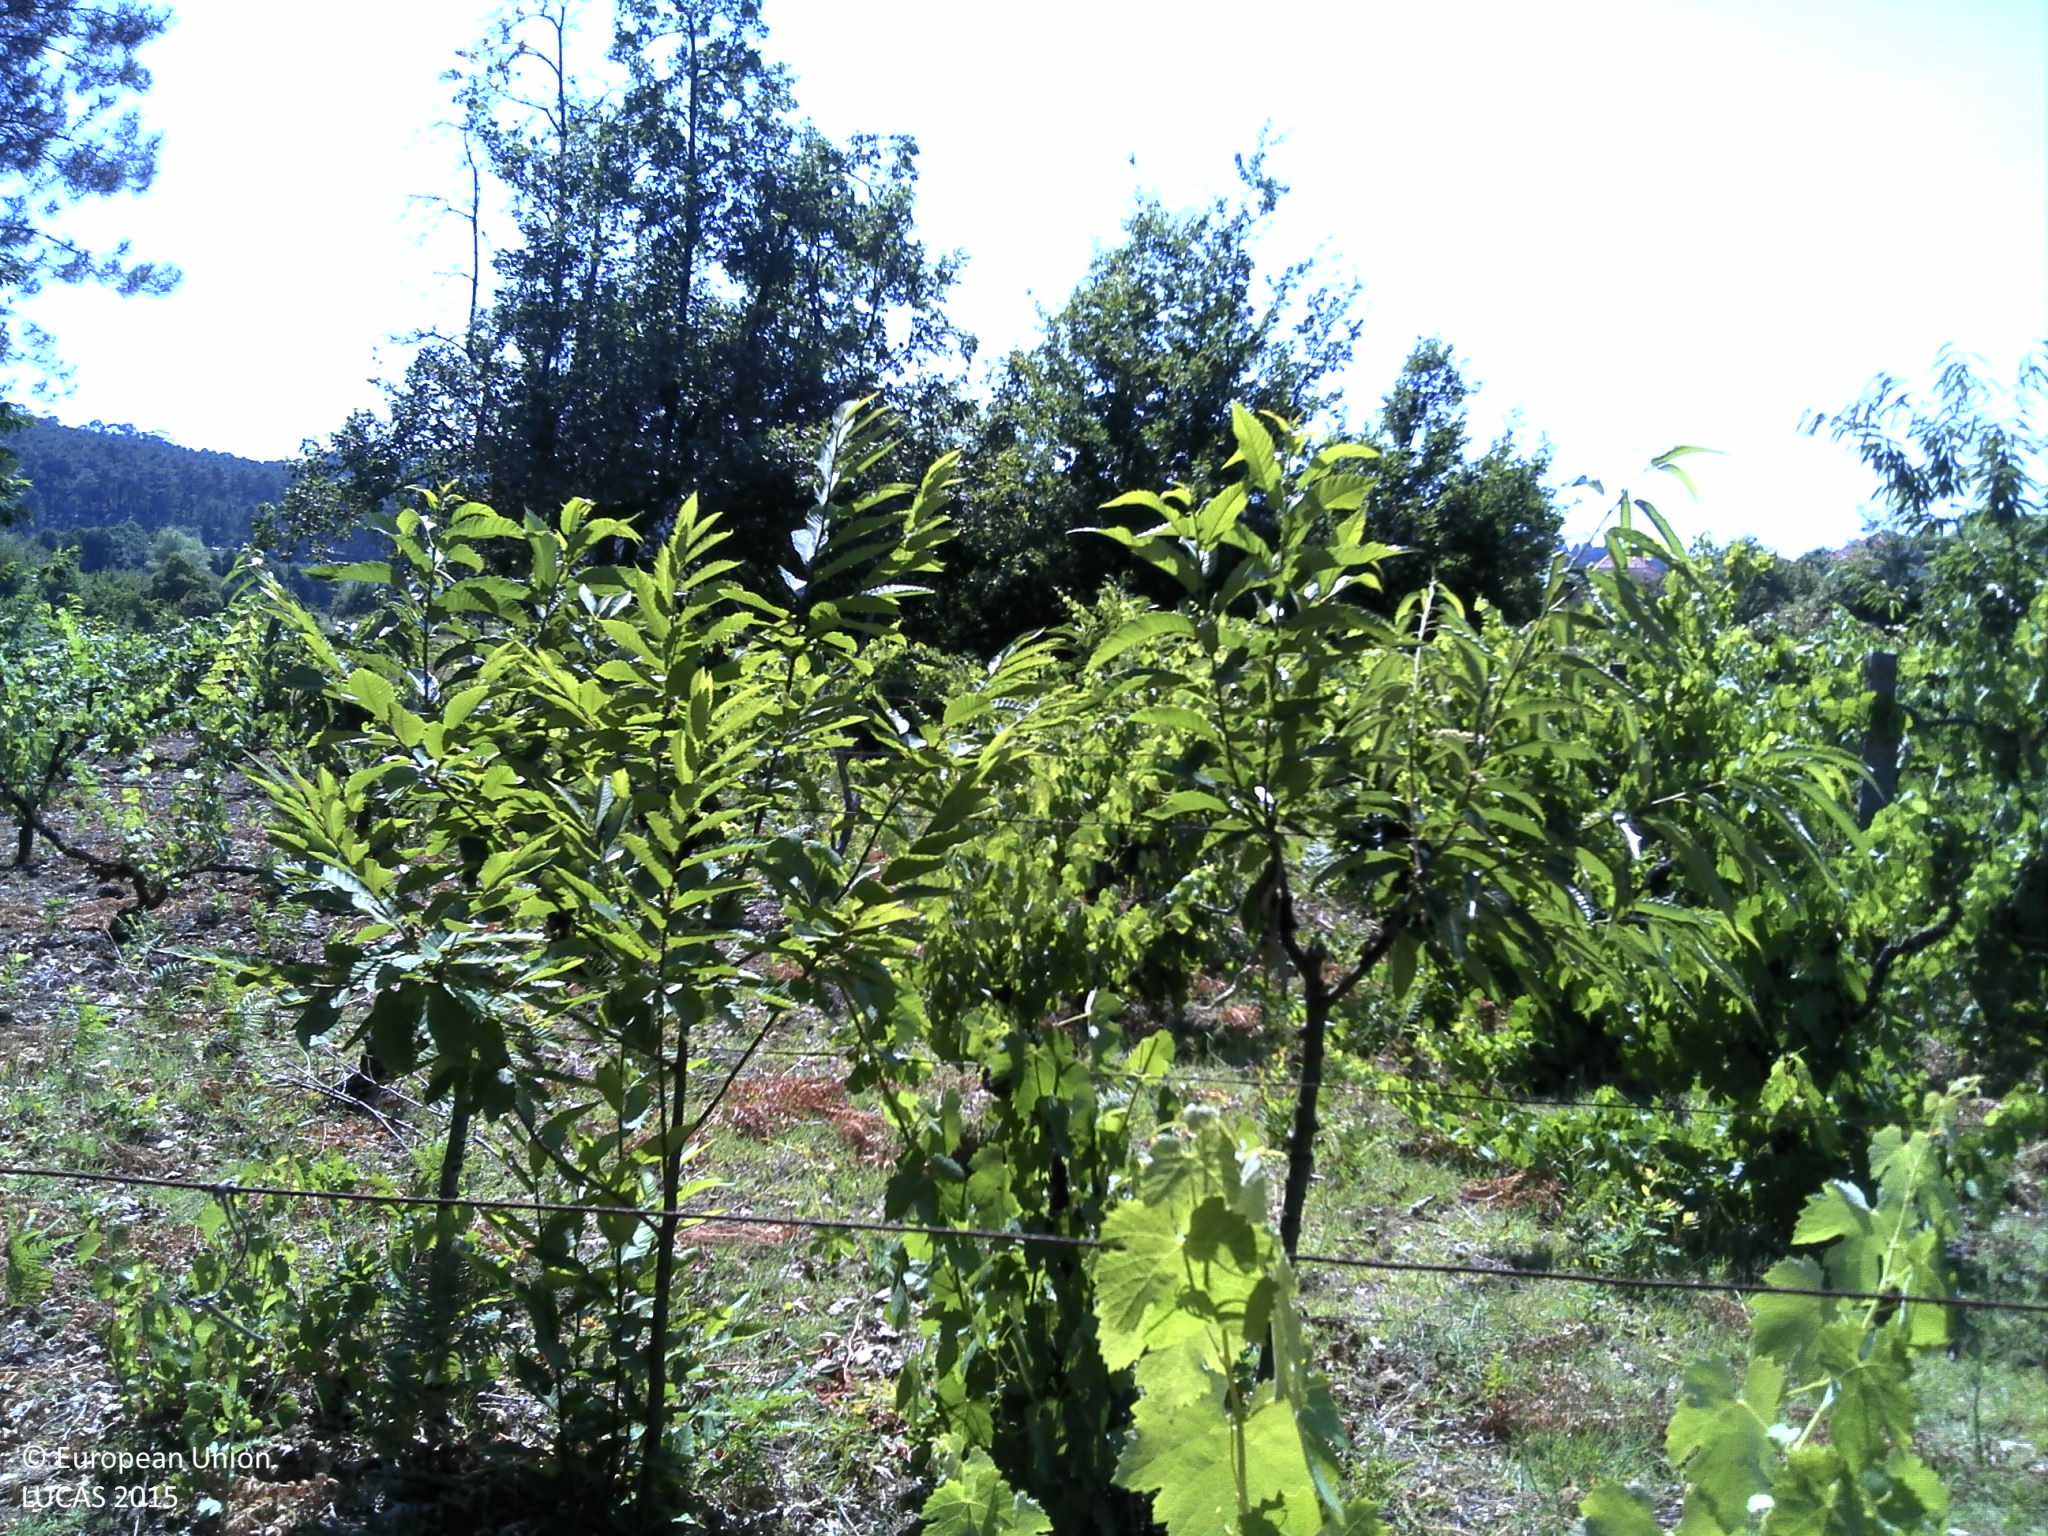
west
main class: Cropland
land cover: Vineyards
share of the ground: 10 - 25 %
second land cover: Grassland without tree/shrub cover
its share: 50 - 75 %
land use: Agriculture (excluding fallow land and kitchen gardens)
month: July
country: PT
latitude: 40.7476
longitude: -7.8053
